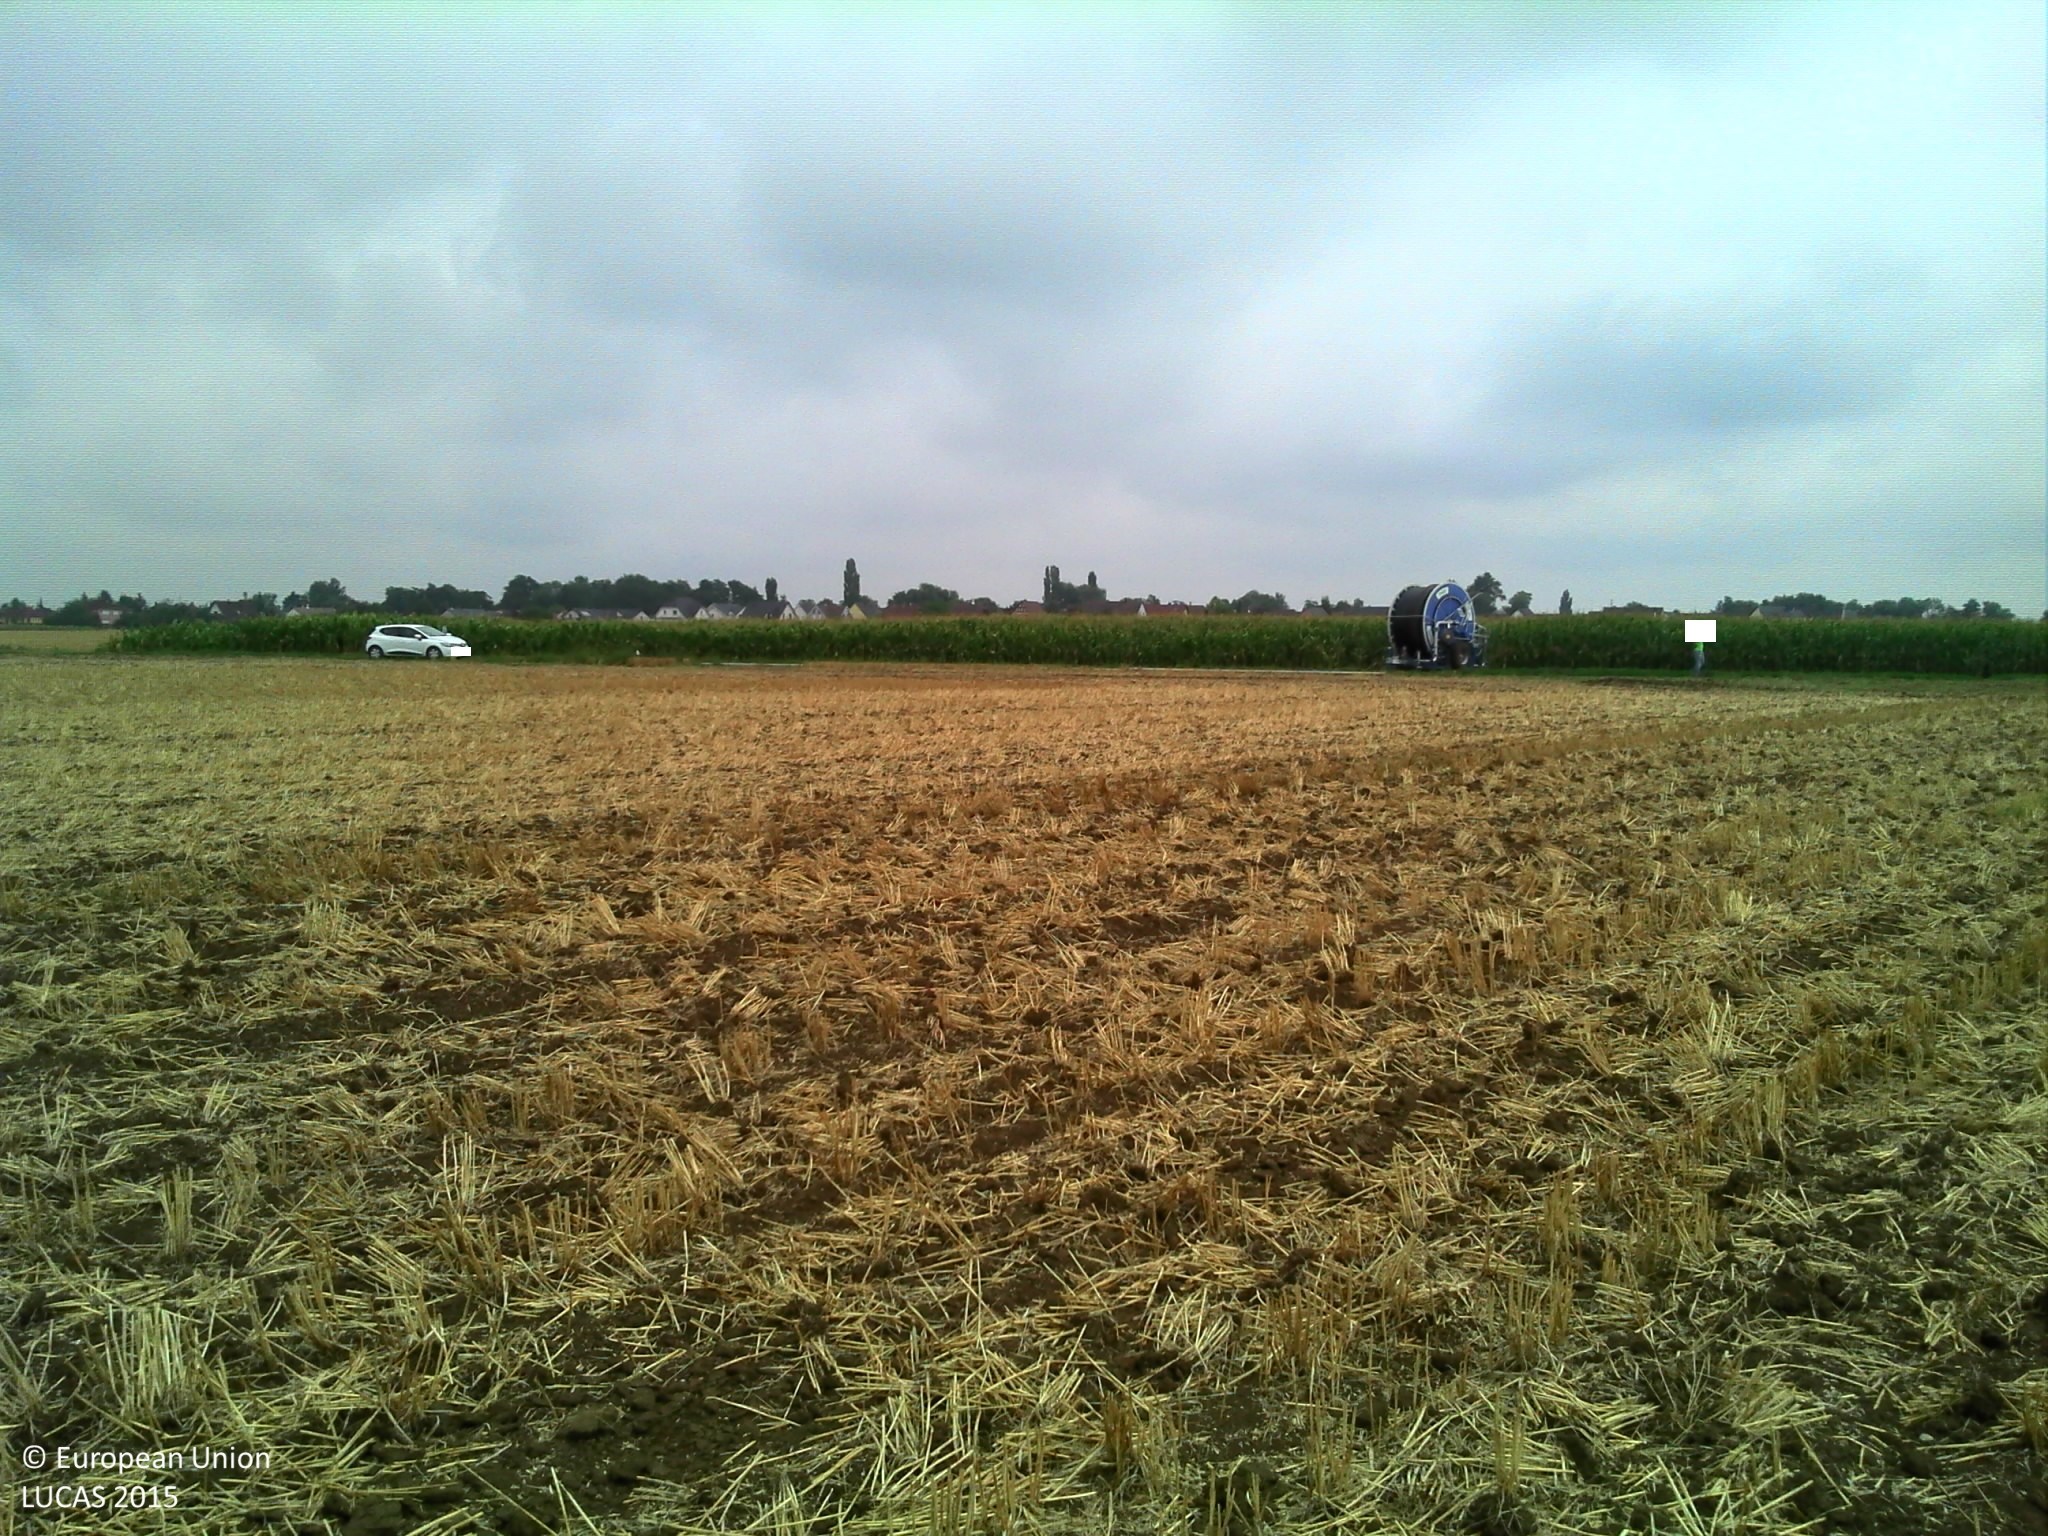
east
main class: Cropland
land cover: Common wheat
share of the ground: 25 - 50 %
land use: Agriculture (excluding fallow land and kitchen gardens)
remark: Tilled/Sowed
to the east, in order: Common wheat; Grass margins; Tracks; Grass margins; Maize
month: August
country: FR
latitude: 47.8141
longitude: 7.3705
